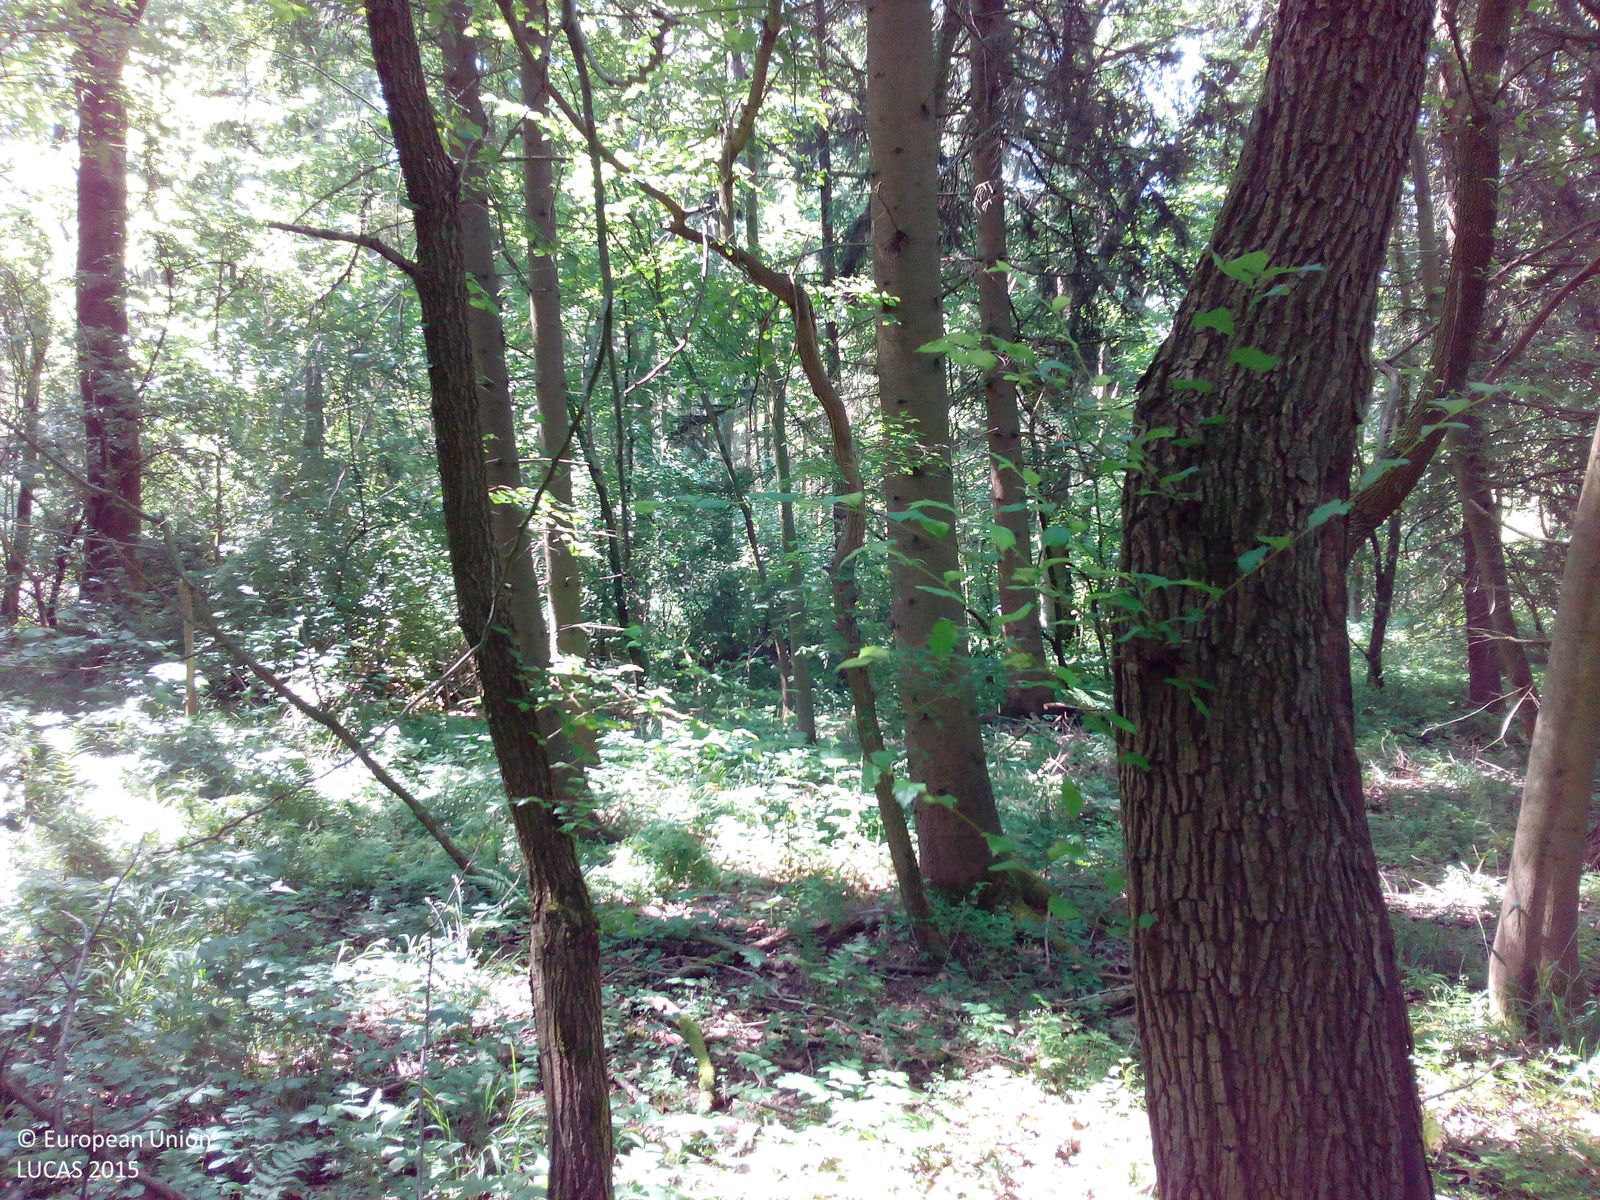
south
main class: Woodland
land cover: Spruce dominated mixed woodland
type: hemiboreal forest and nemoral coniferous forest and mixed broadleaved-coniferous forest
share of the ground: > 75 %
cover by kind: broadleaved forest trees 65 %, coniferous forest trees 25 %, herbaceous plants 10 %
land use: Community services
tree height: > 5 m
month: June
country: DE
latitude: 51.8381
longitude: 9.8694
